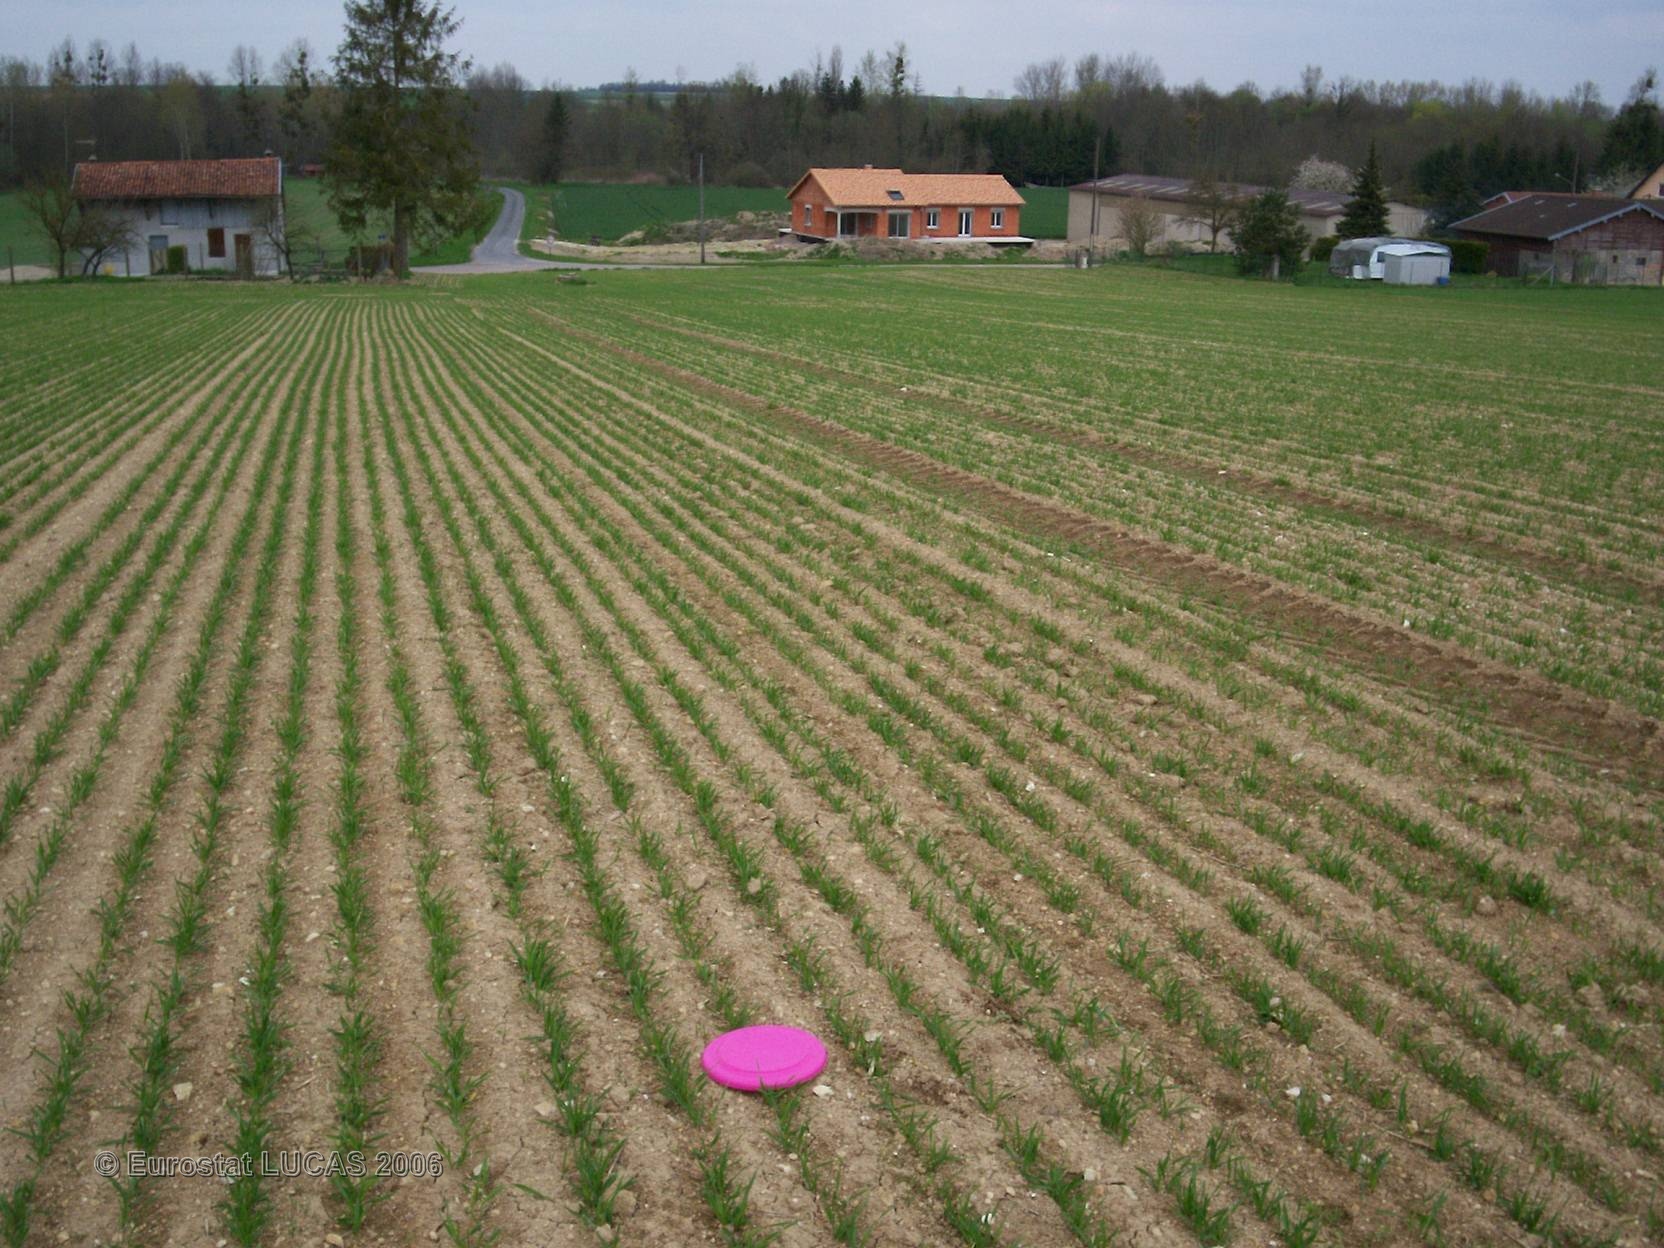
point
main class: Cropland
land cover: Barley
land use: Agriculture (excluding fallow land and kitchen gardens)
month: April
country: FR
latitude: 48.4813
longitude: 4.4639
